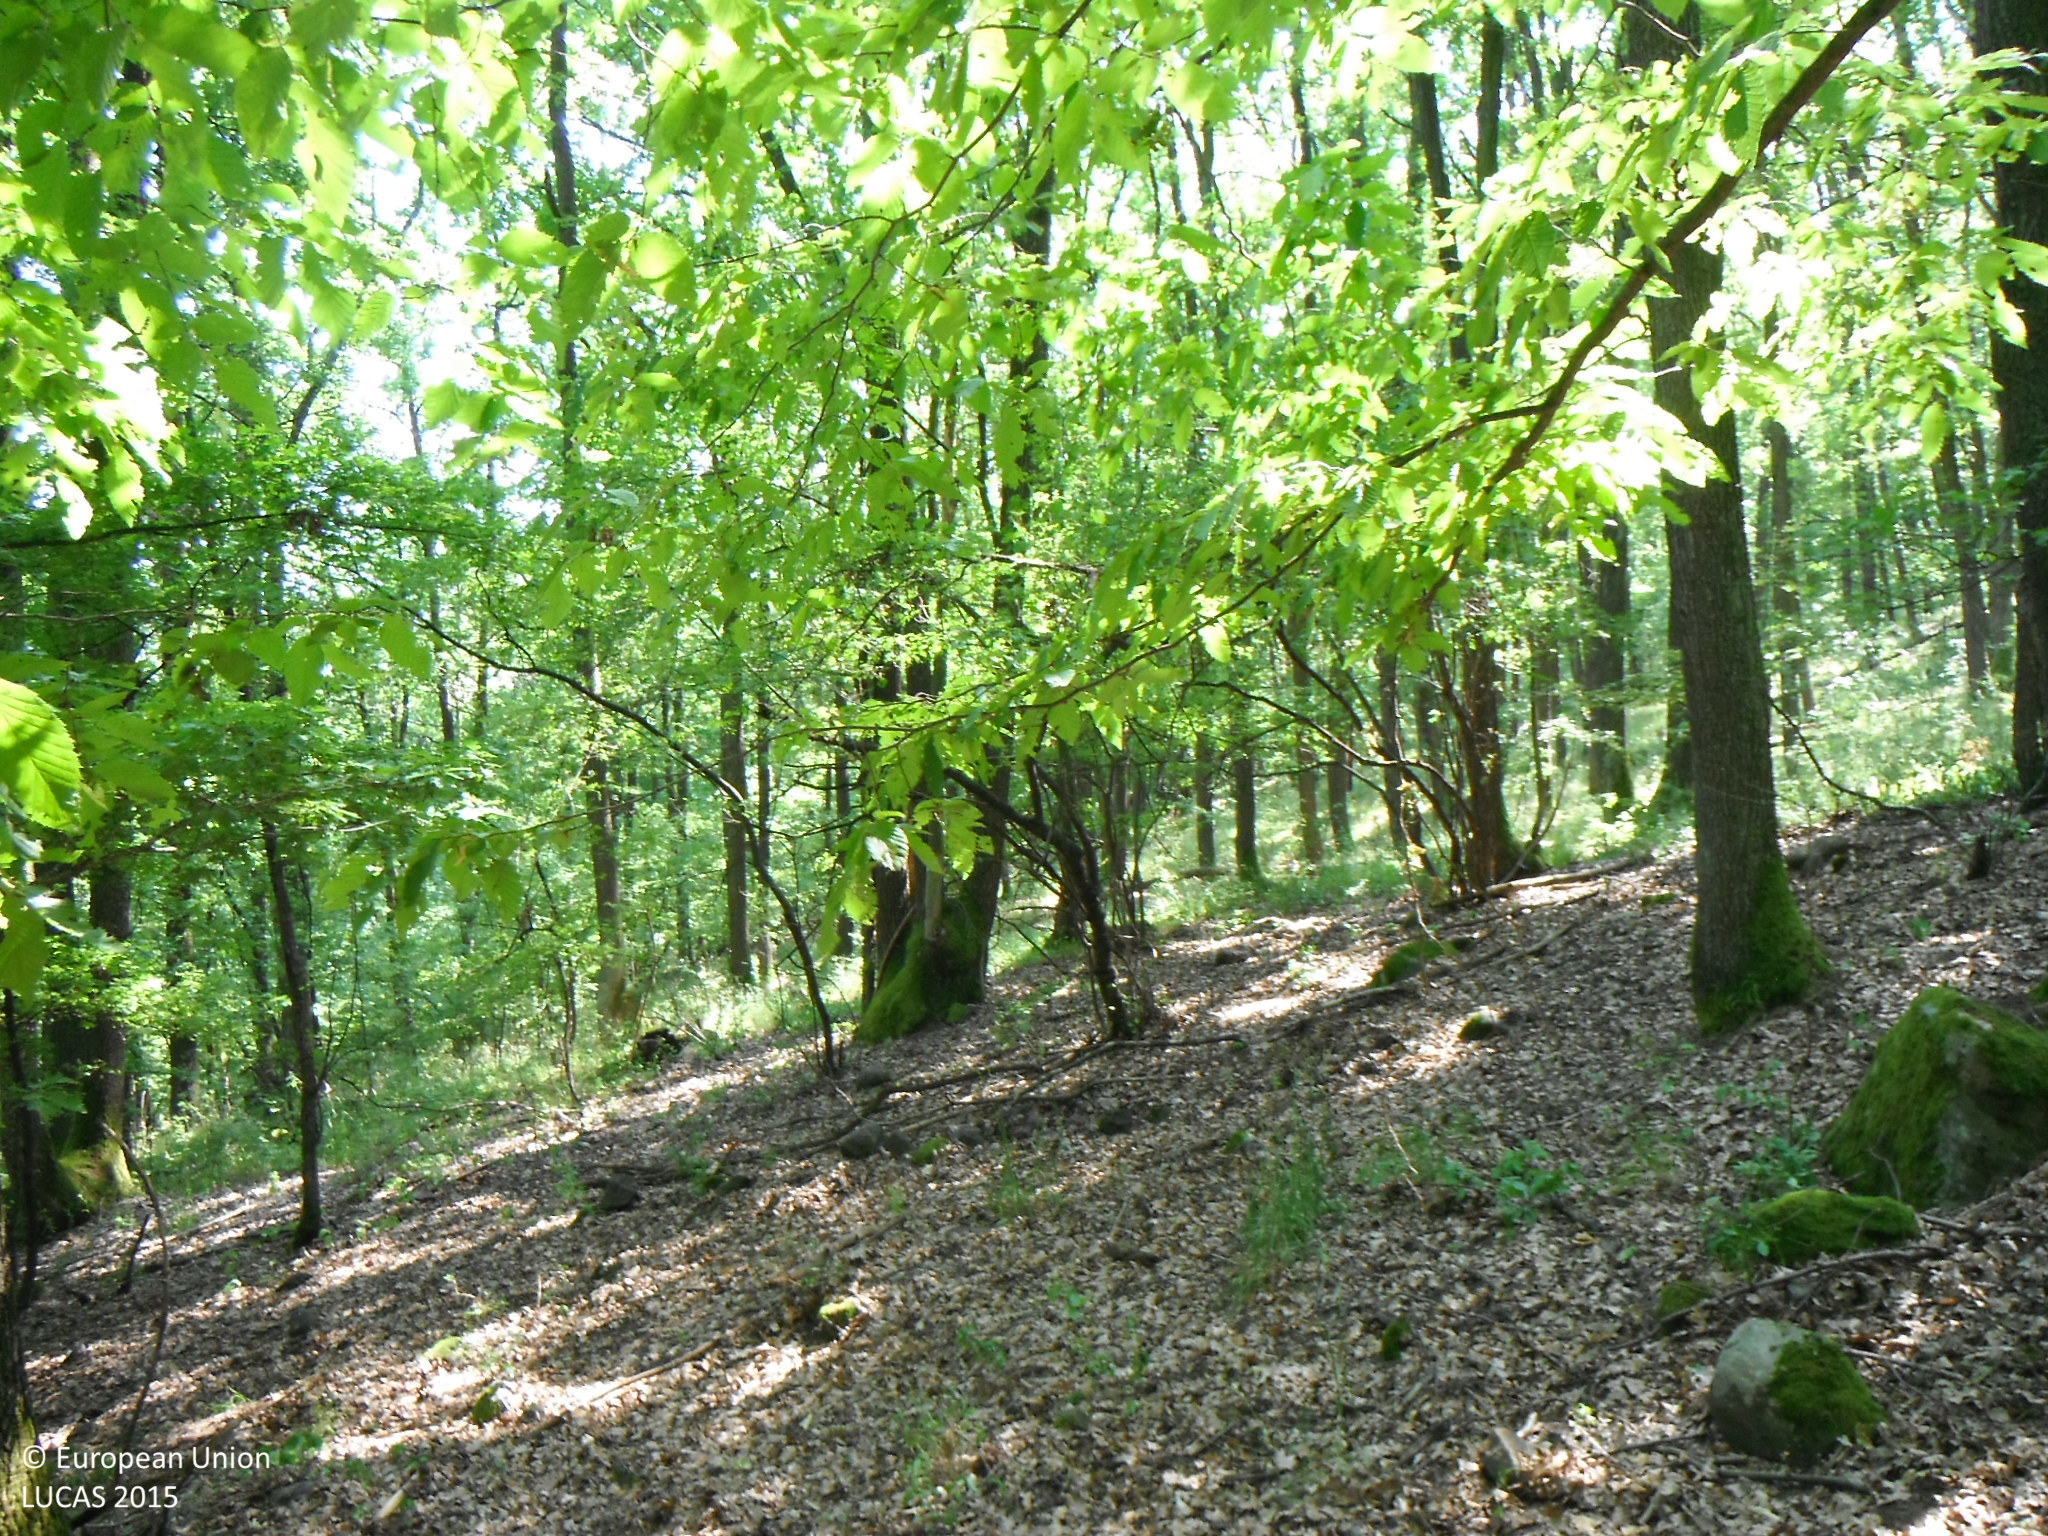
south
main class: Woodland
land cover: Broadleaved woodland
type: acidophilous oak and oak-birch forest
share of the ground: > 75 %
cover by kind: broadleaved forest trees 100 %
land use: Forestry
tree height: > 5 m
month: July
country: SK
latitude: 48.1370
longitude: 19.0910
